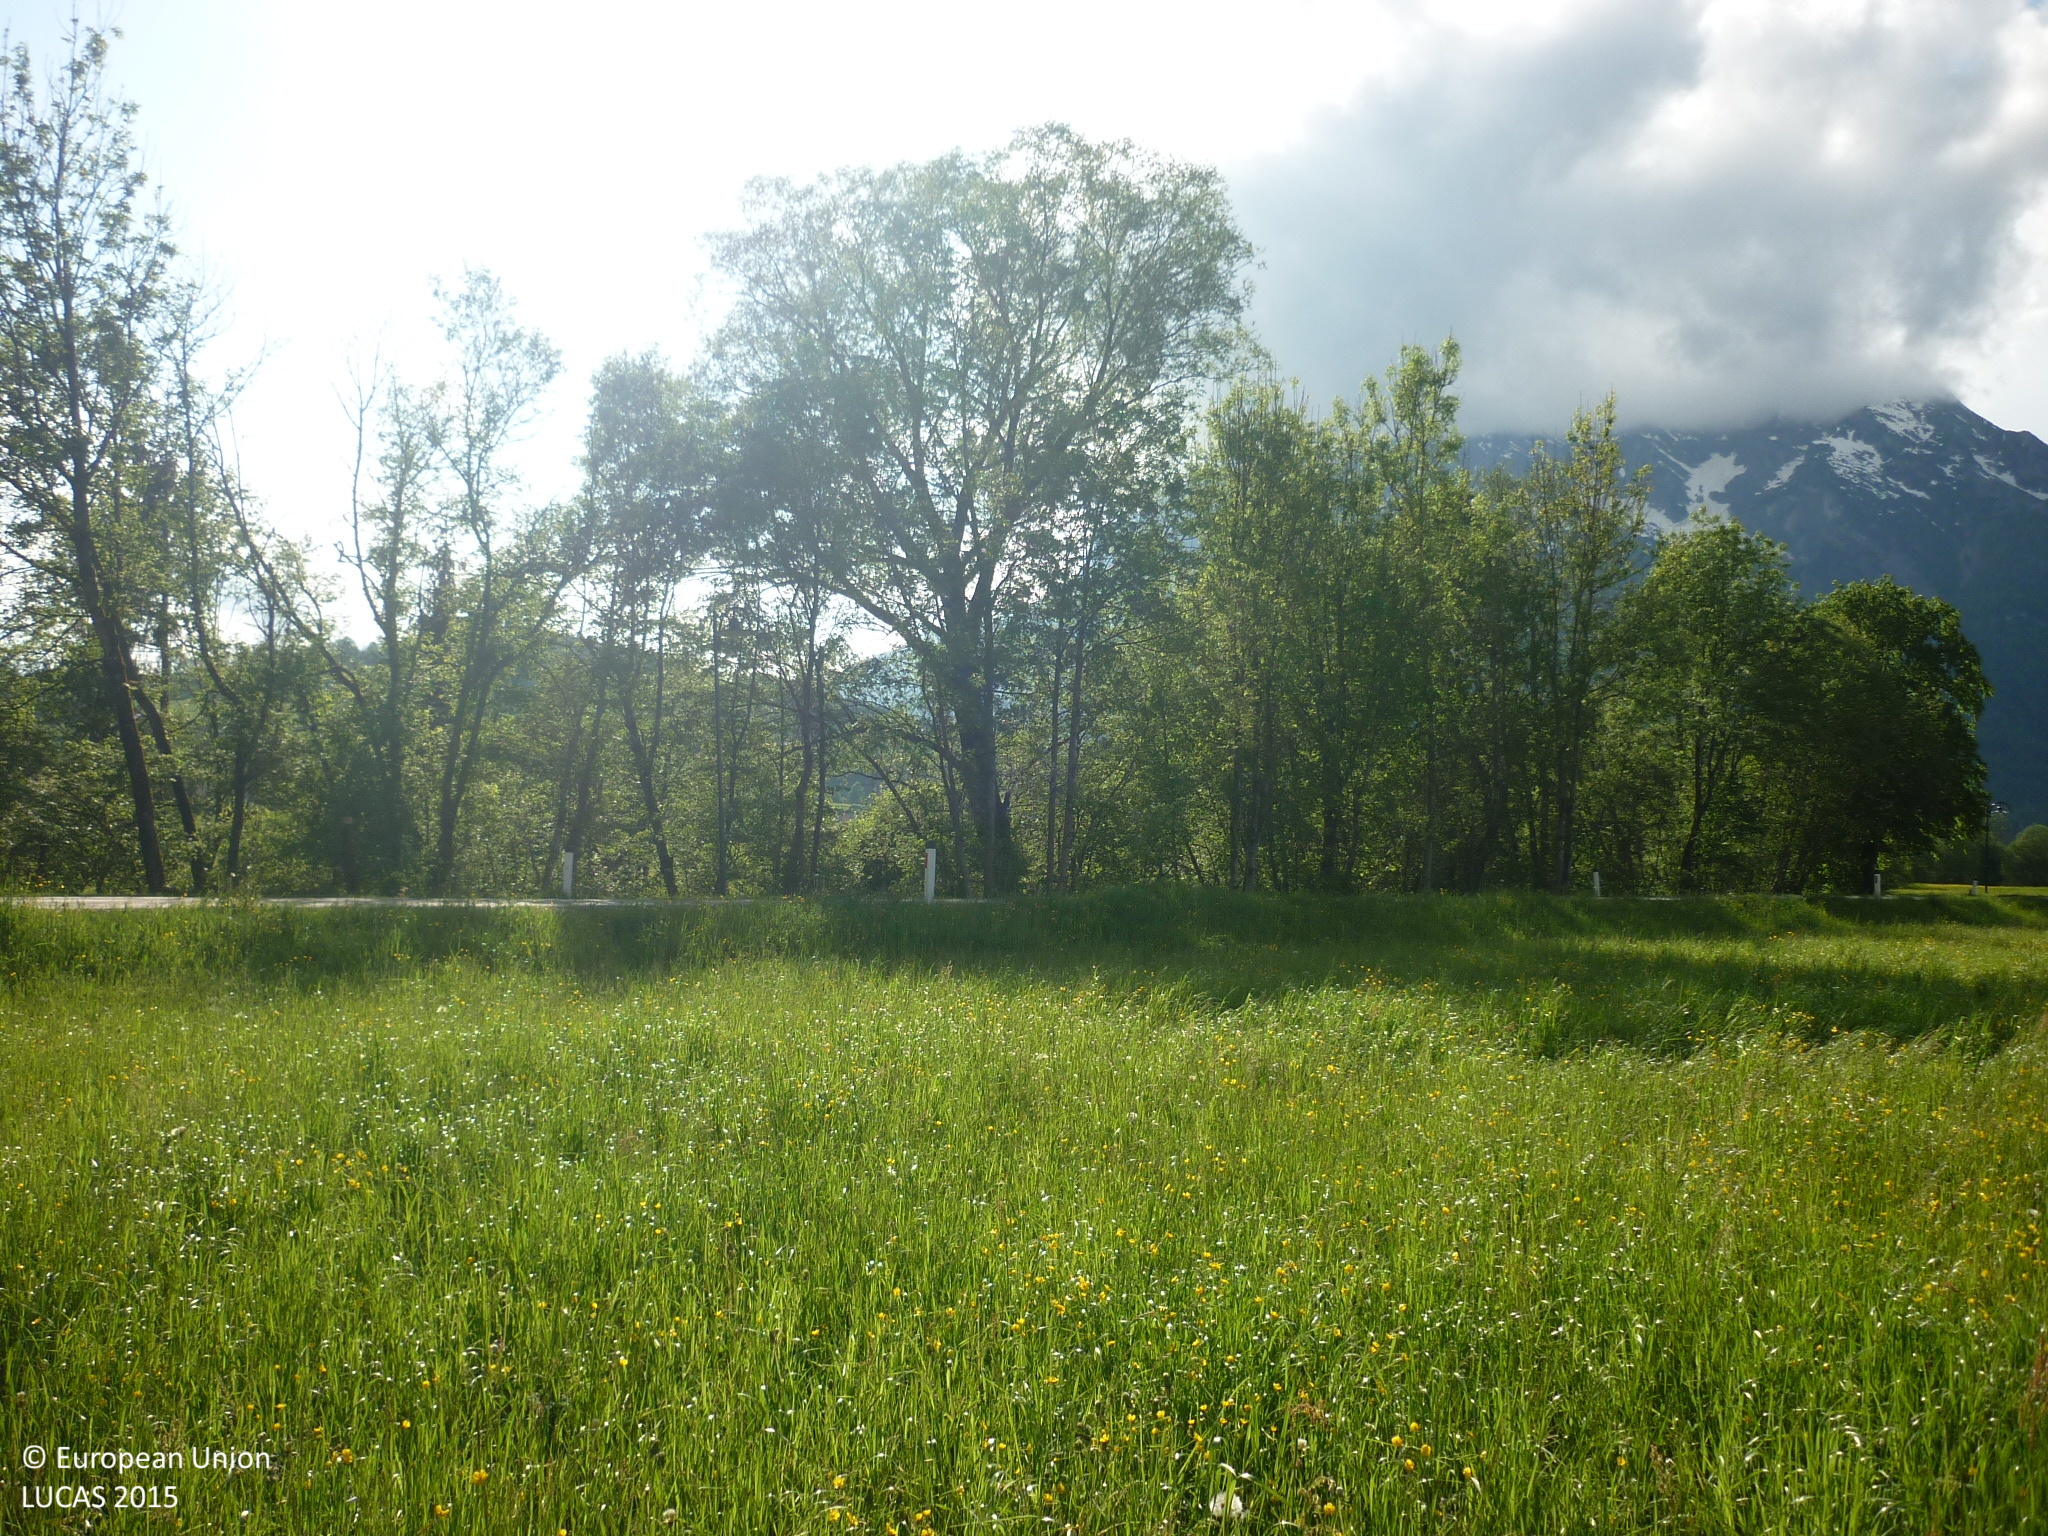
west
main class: Grassland
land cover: Grassland without tree/shrub cover
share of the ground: > 75 %
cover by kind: herbaceous plants 100 %
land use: Agriculture (excluding fallow land and kitchen gardens)
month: May
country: AT
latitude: 47.4986
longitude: 14.1007
